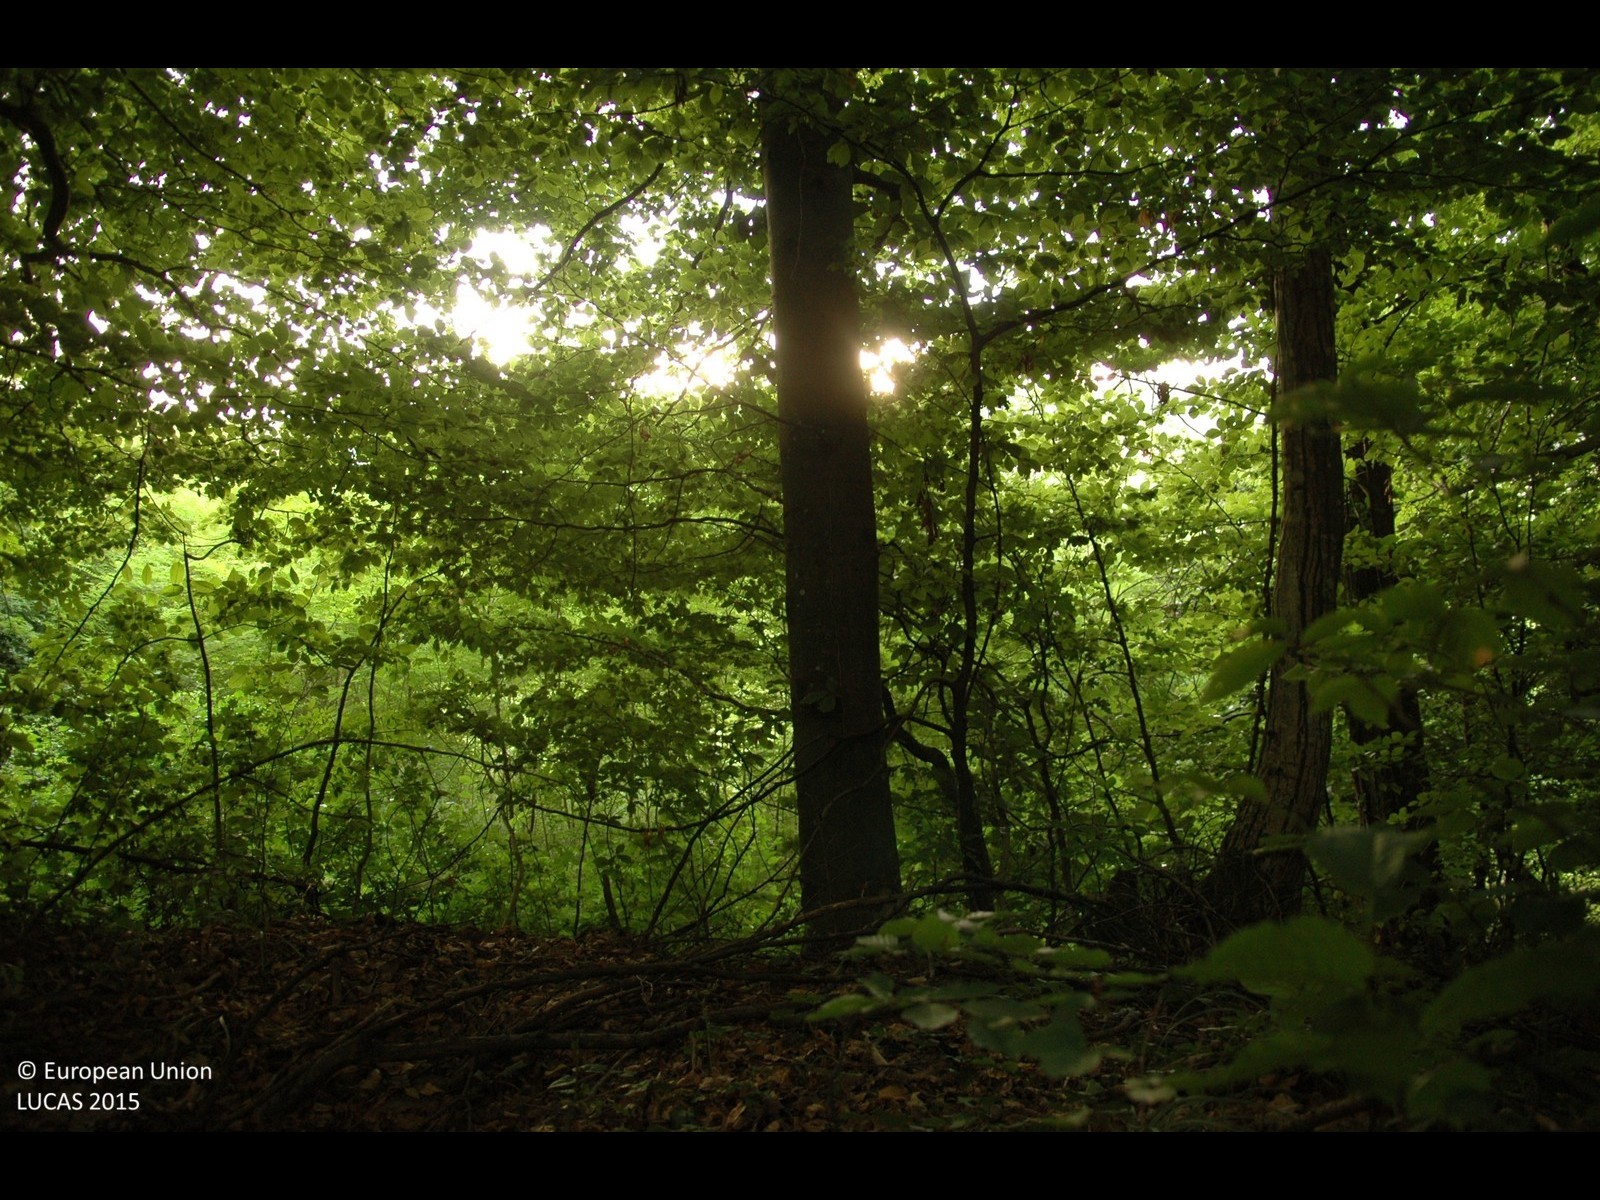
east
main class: Woodland
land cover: Broadleaved woodland
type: beech forest
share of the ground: > 75 %
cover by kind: broadleaved forest trees 100 %
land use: Forestry
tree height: > 5 m
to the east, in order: Broadleaved woodland; Grassland without tree/shrub cover; Dry pulses; Other fruit trees and berries; Tomatoes; Maize; Grassland without tree/shrub cover; Ditches and canals; Grassland without tree/shrub cover; Maize; Grassland without tree/shrub cover; Paved roads, cycling and walking lanes
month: July
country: HR
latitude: 46.2414
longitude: 16.2377
